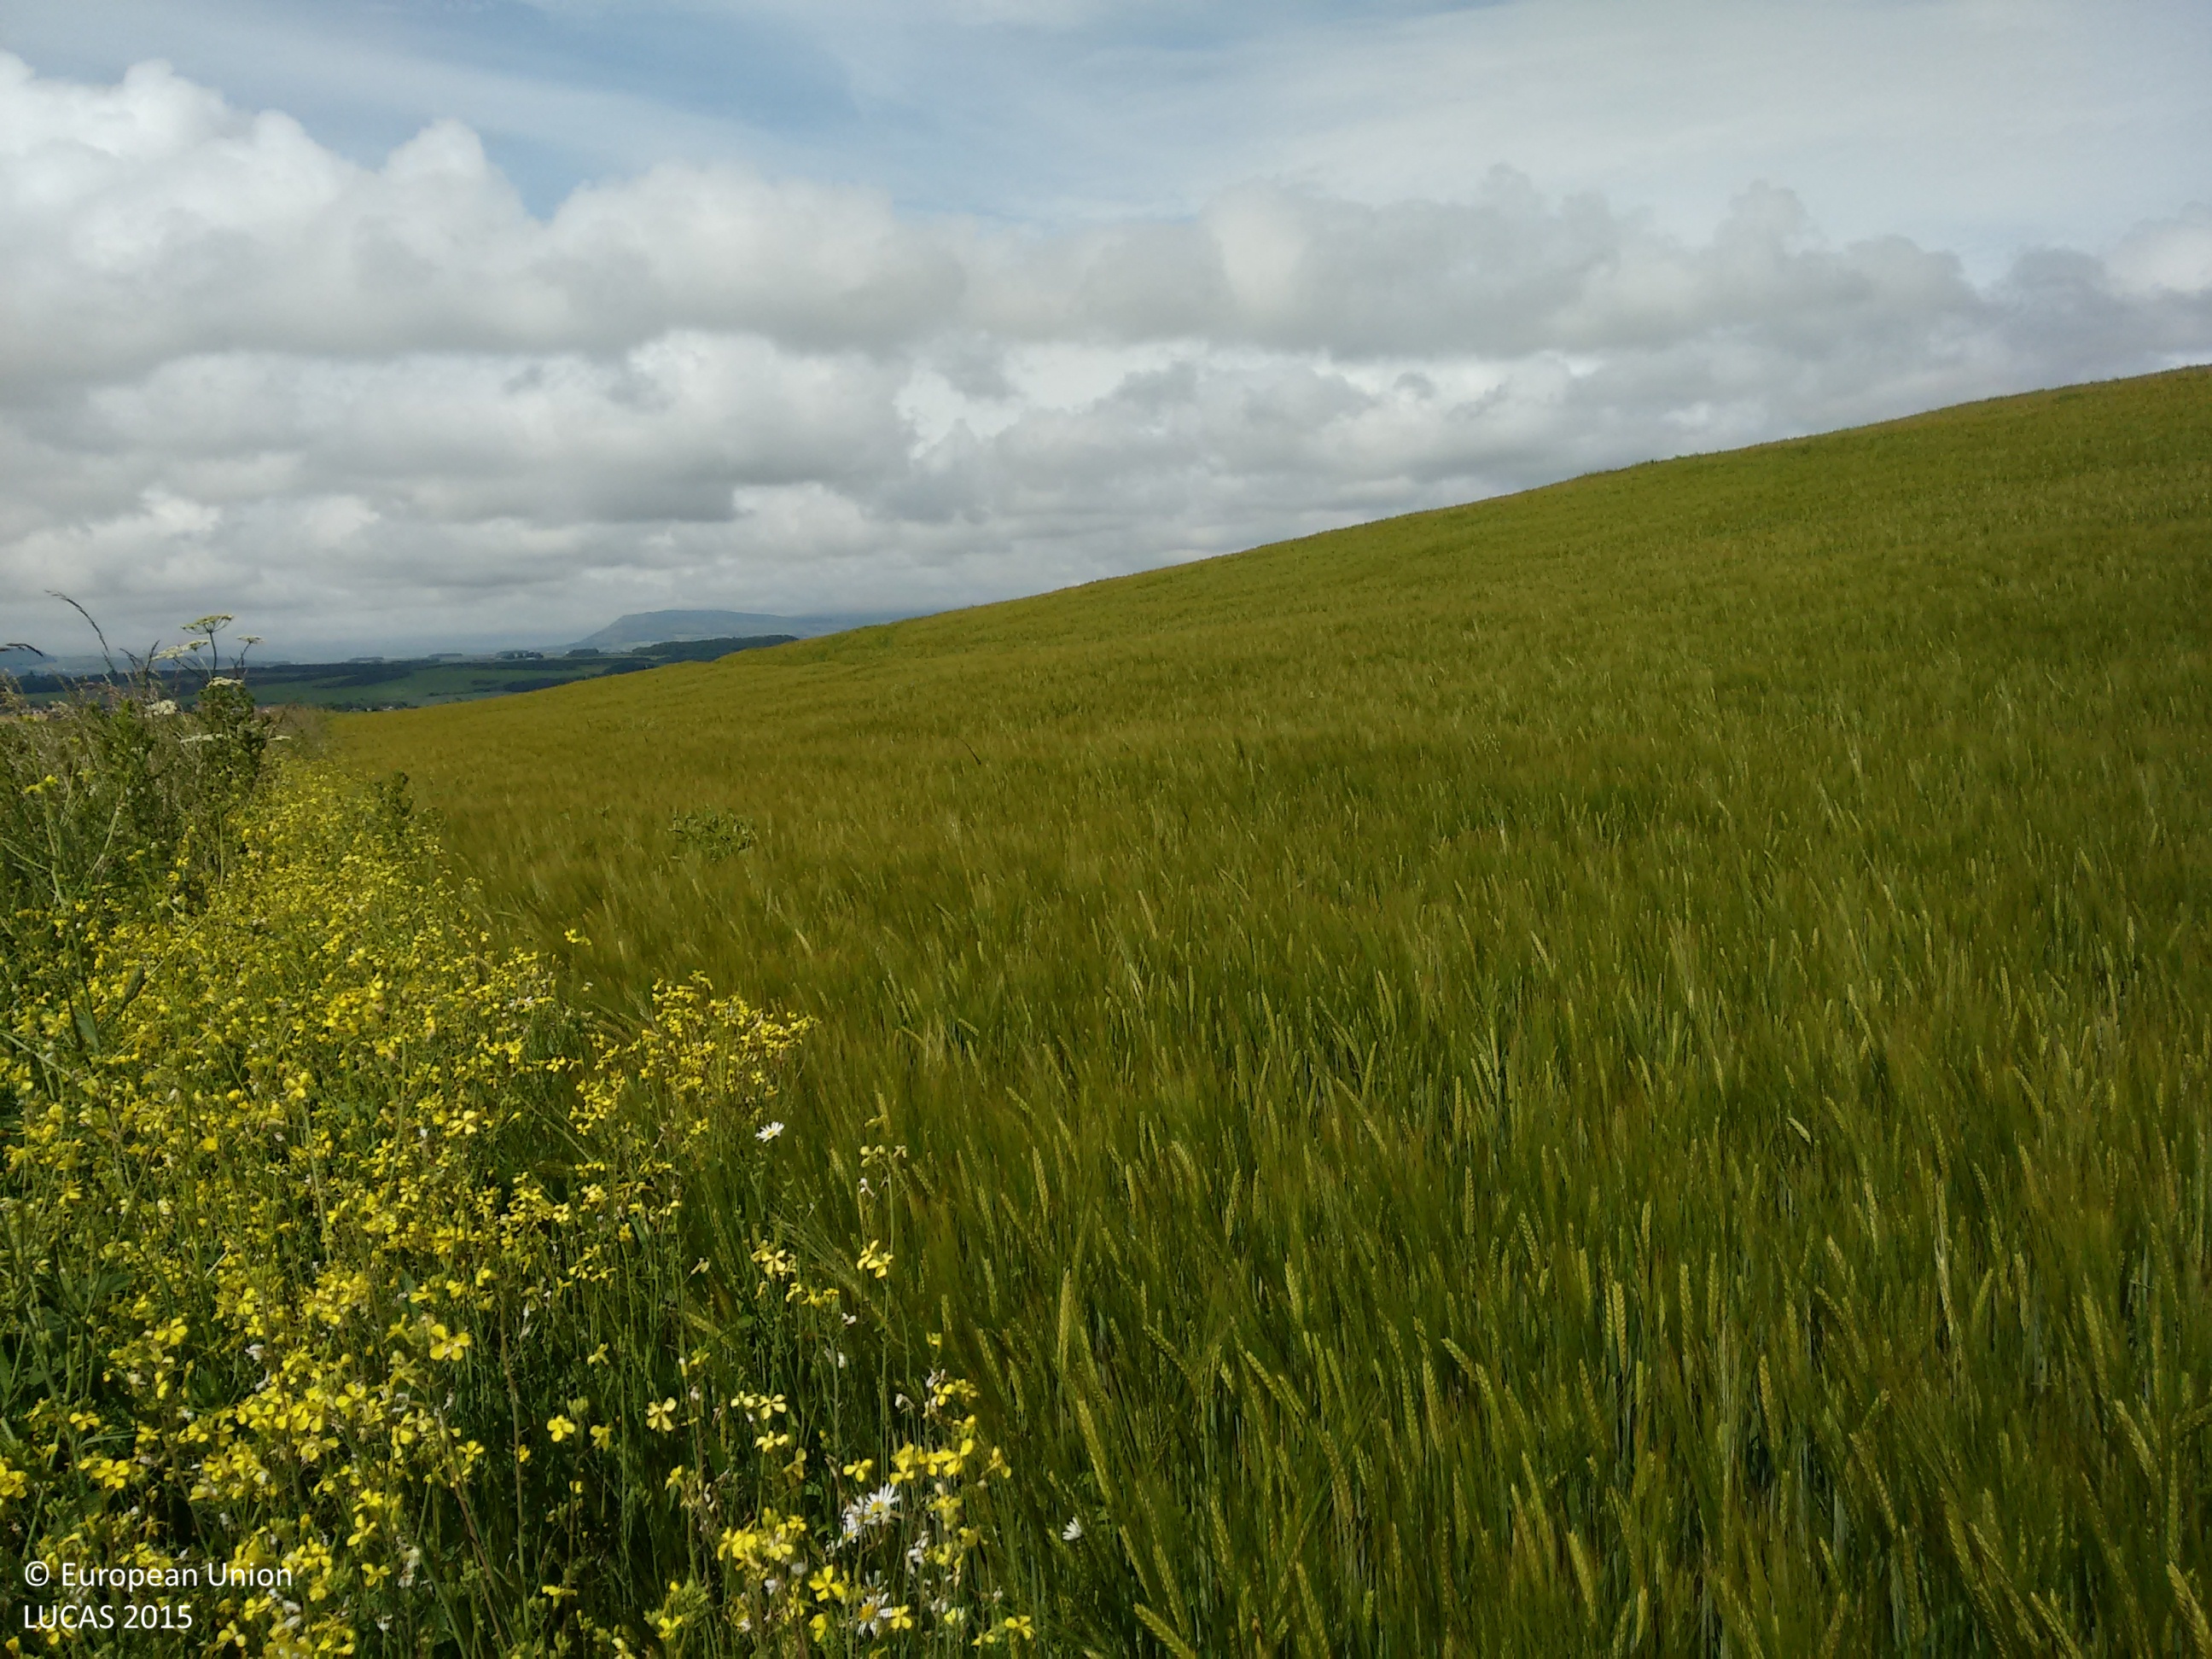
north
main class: Cropland
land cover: Barley
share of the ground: > 75 %
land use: Agriculture (excluding fallow land and kitchen gardens)
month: July
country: GB
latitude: 56.0825
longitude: -3.2323
